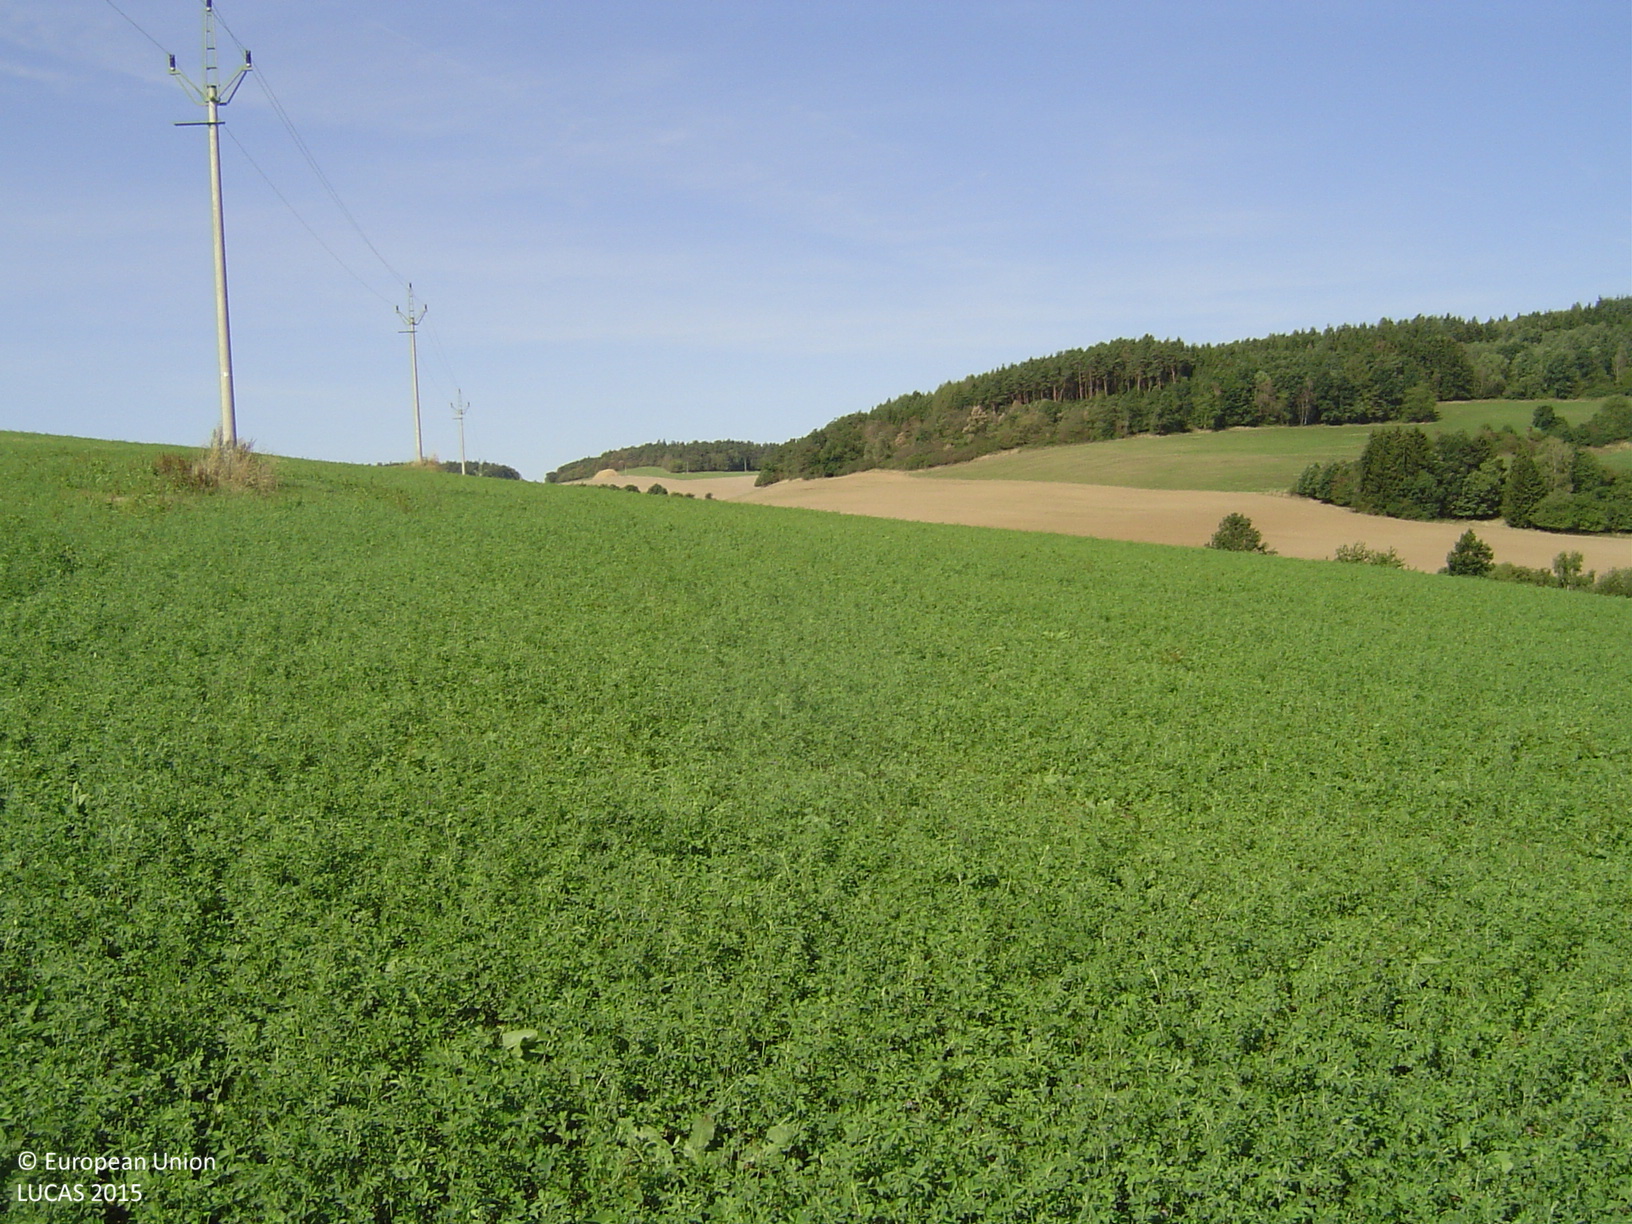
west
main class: Cropland
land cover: Lucerne
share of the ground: > 75 %
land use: Agriculture (excluding fallow land and kitchen gardens)
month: August
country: CZ
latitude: 49.5808
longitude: 14.3026
